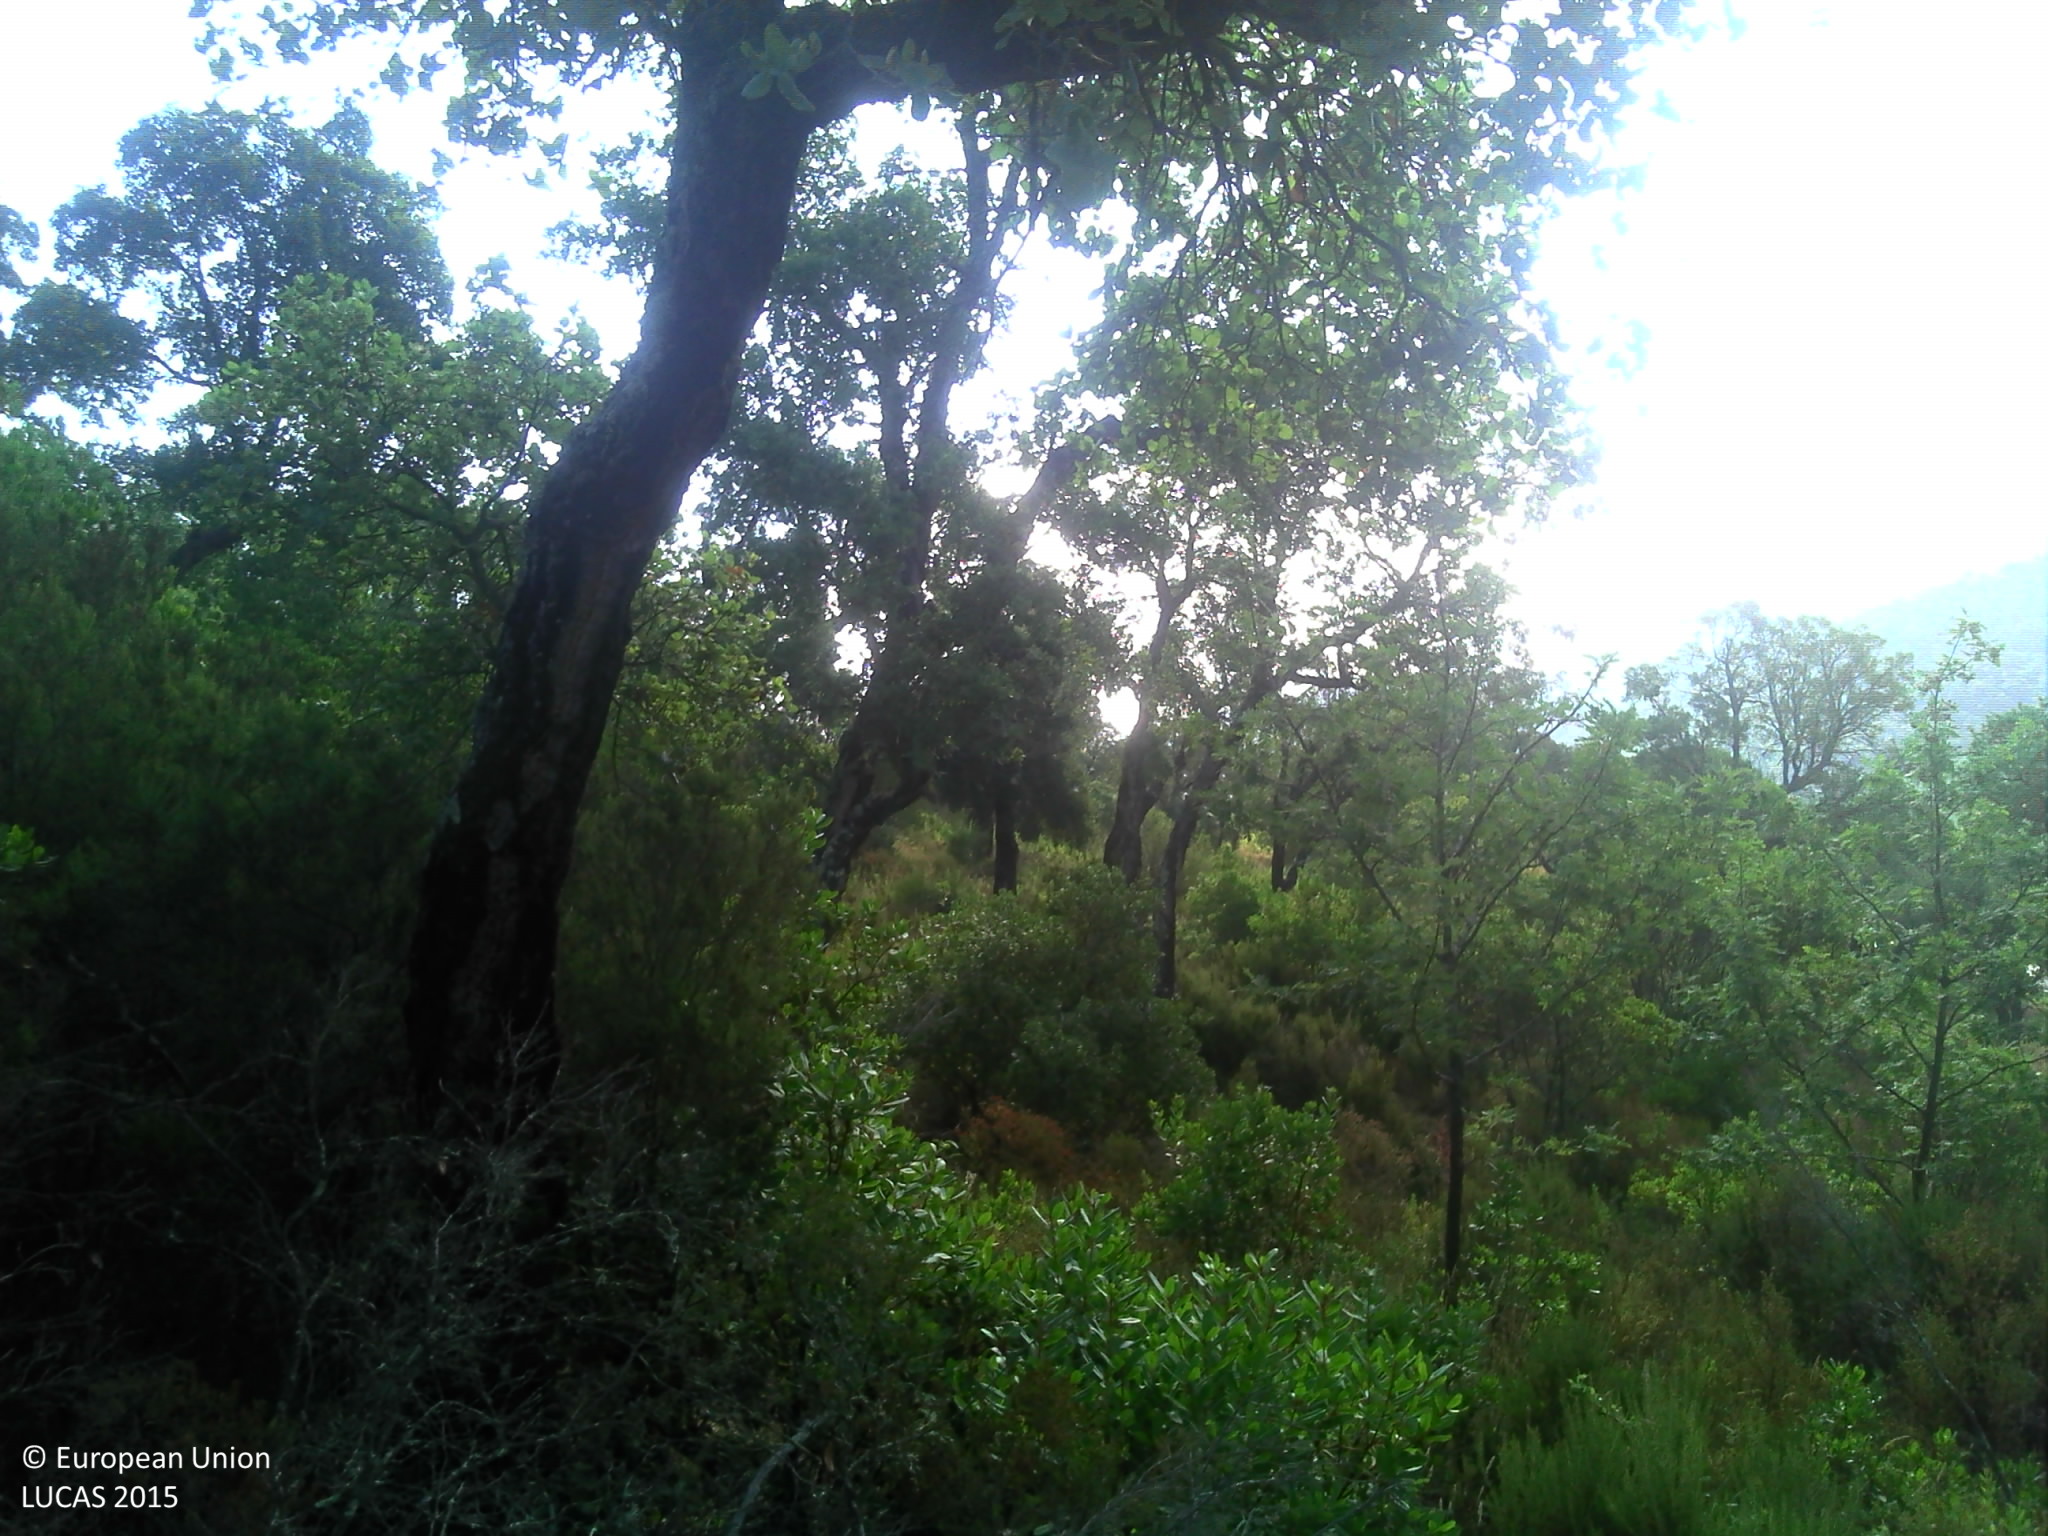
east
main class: Shrubland
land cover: Shrubland with sparse tree cover
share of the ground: > 75 %
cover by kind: shrubs 90 %, broadleaved forest trees 5 %, unconsolidated bare surface 5 %
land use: Semi-natural and natural areas not in use
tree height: < 5 m
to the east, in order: Shrubland with sparse tree cover; Electric lines; Shrubland without tree cover; Shrubland with sparse tree cover; Rock outcrops; Shrubland with sparse tree cover
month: July
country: FR
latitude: 43.1849
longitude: 6.3553
